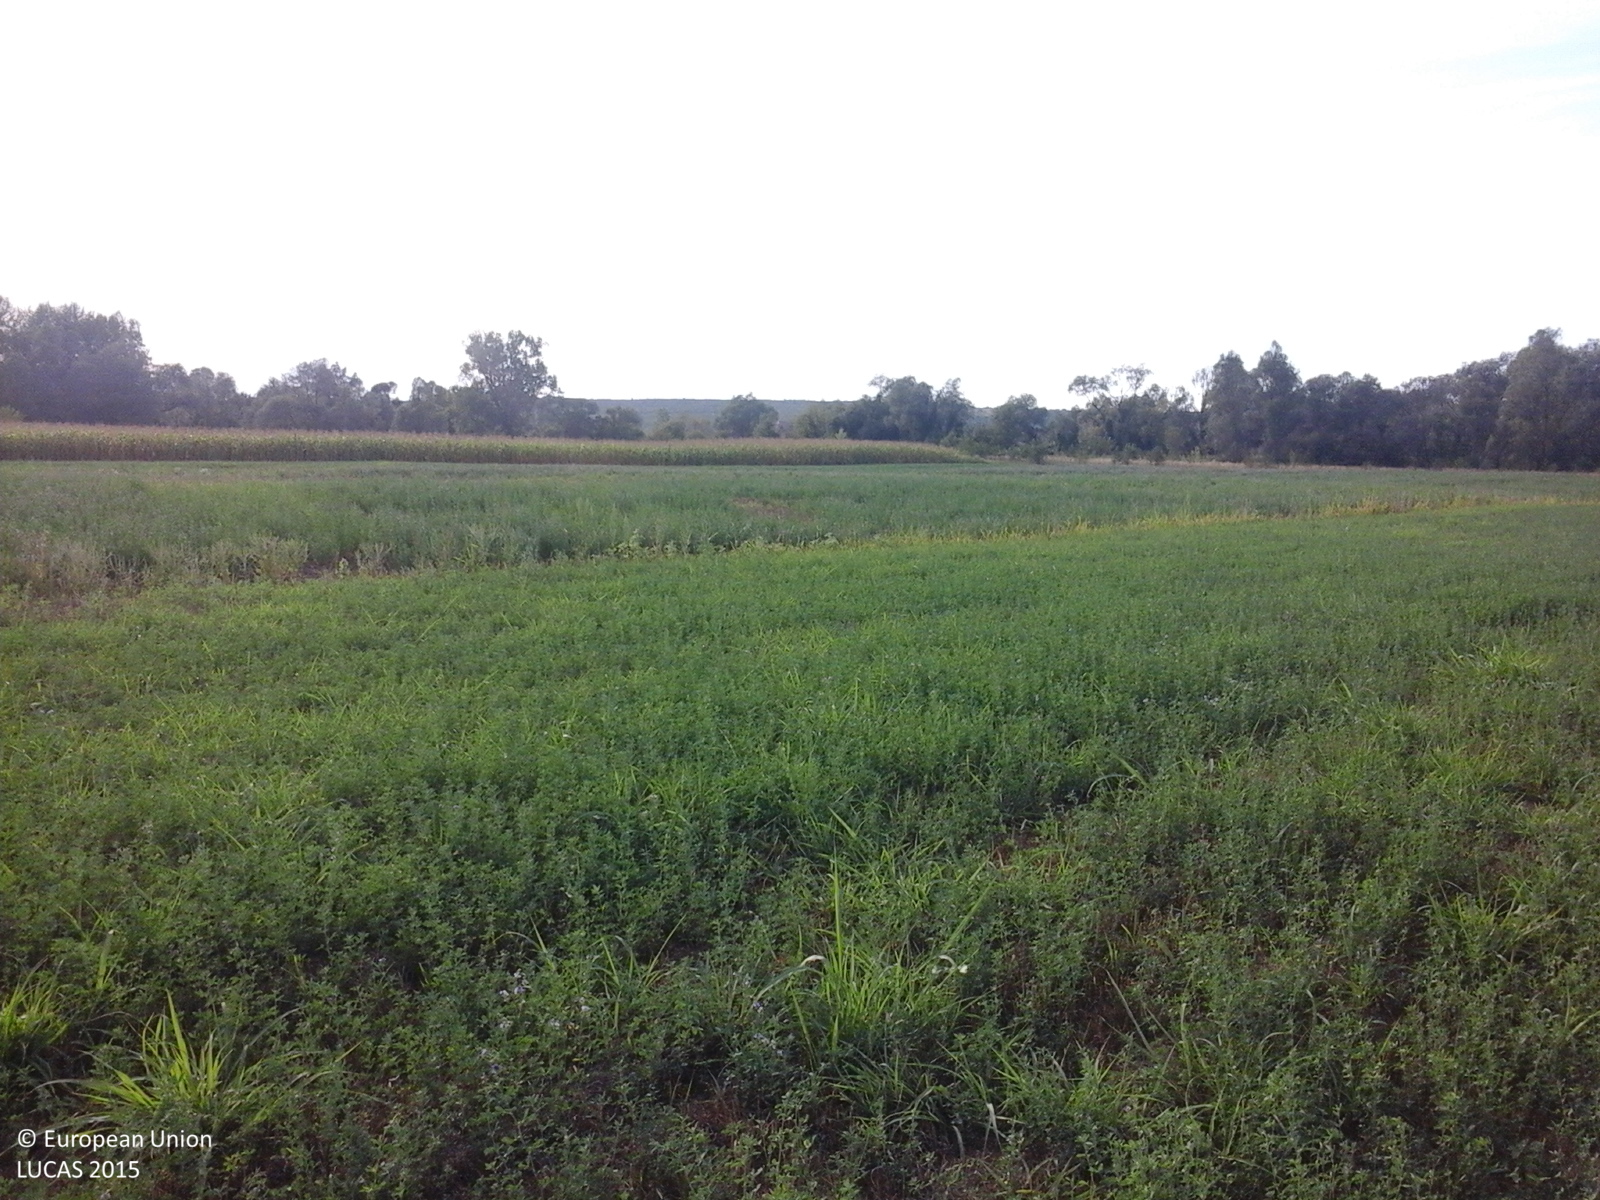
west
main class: Cropland
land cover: Lucerne
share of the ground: > 75 %
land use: Agriculture (excluding fallow land and kitchen gardens)
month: August
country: RO
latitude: 45.1311
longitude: 21.6404
